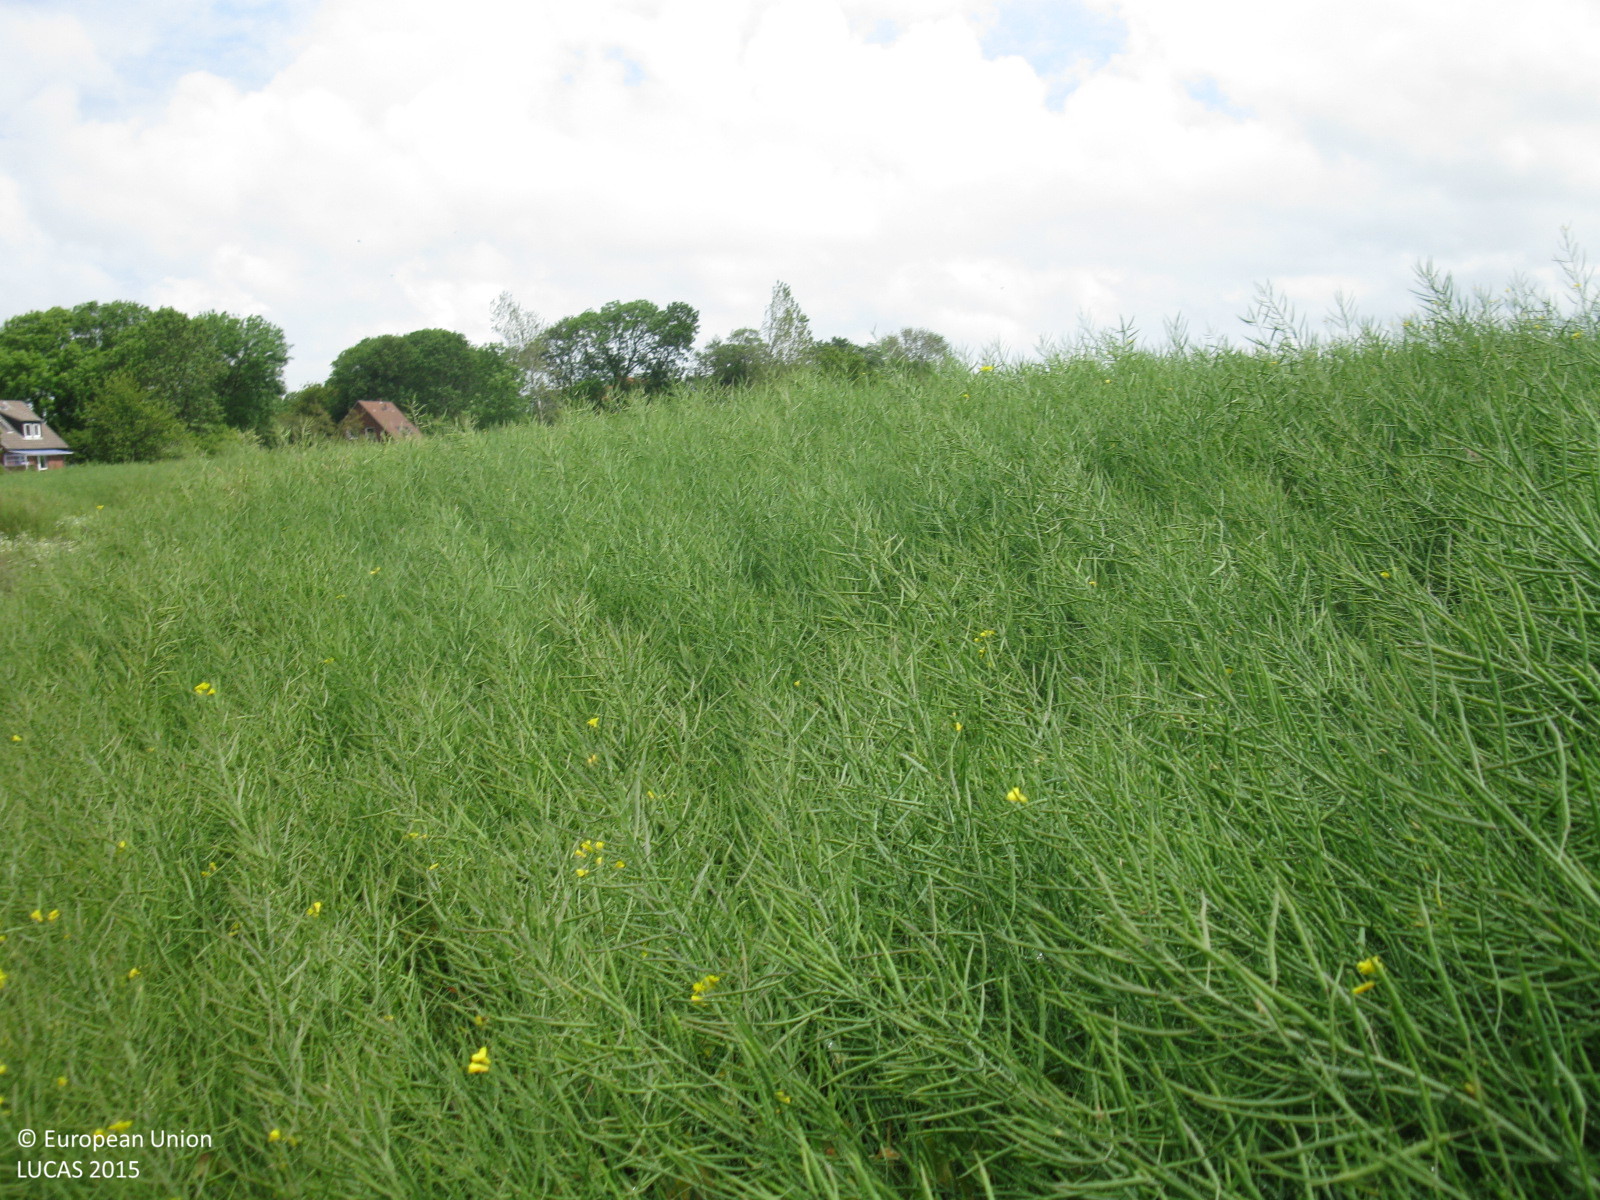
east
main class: Cropland
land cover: Rape and turnip rape
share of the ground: > 75 %
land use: Agriculture (excluding fallow land and kitchen gardens)
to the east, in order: Rape and turnip rape; Tracks; Ditches and canals; Grass margins; Rape and turnip rape; Grass margins; Ditches and canals; Broadleaved woodland; Grassland without tree/shrub cover; Artificial constructions in urban areas
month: June
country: DE
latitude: 53.7088
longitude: 7.9858
